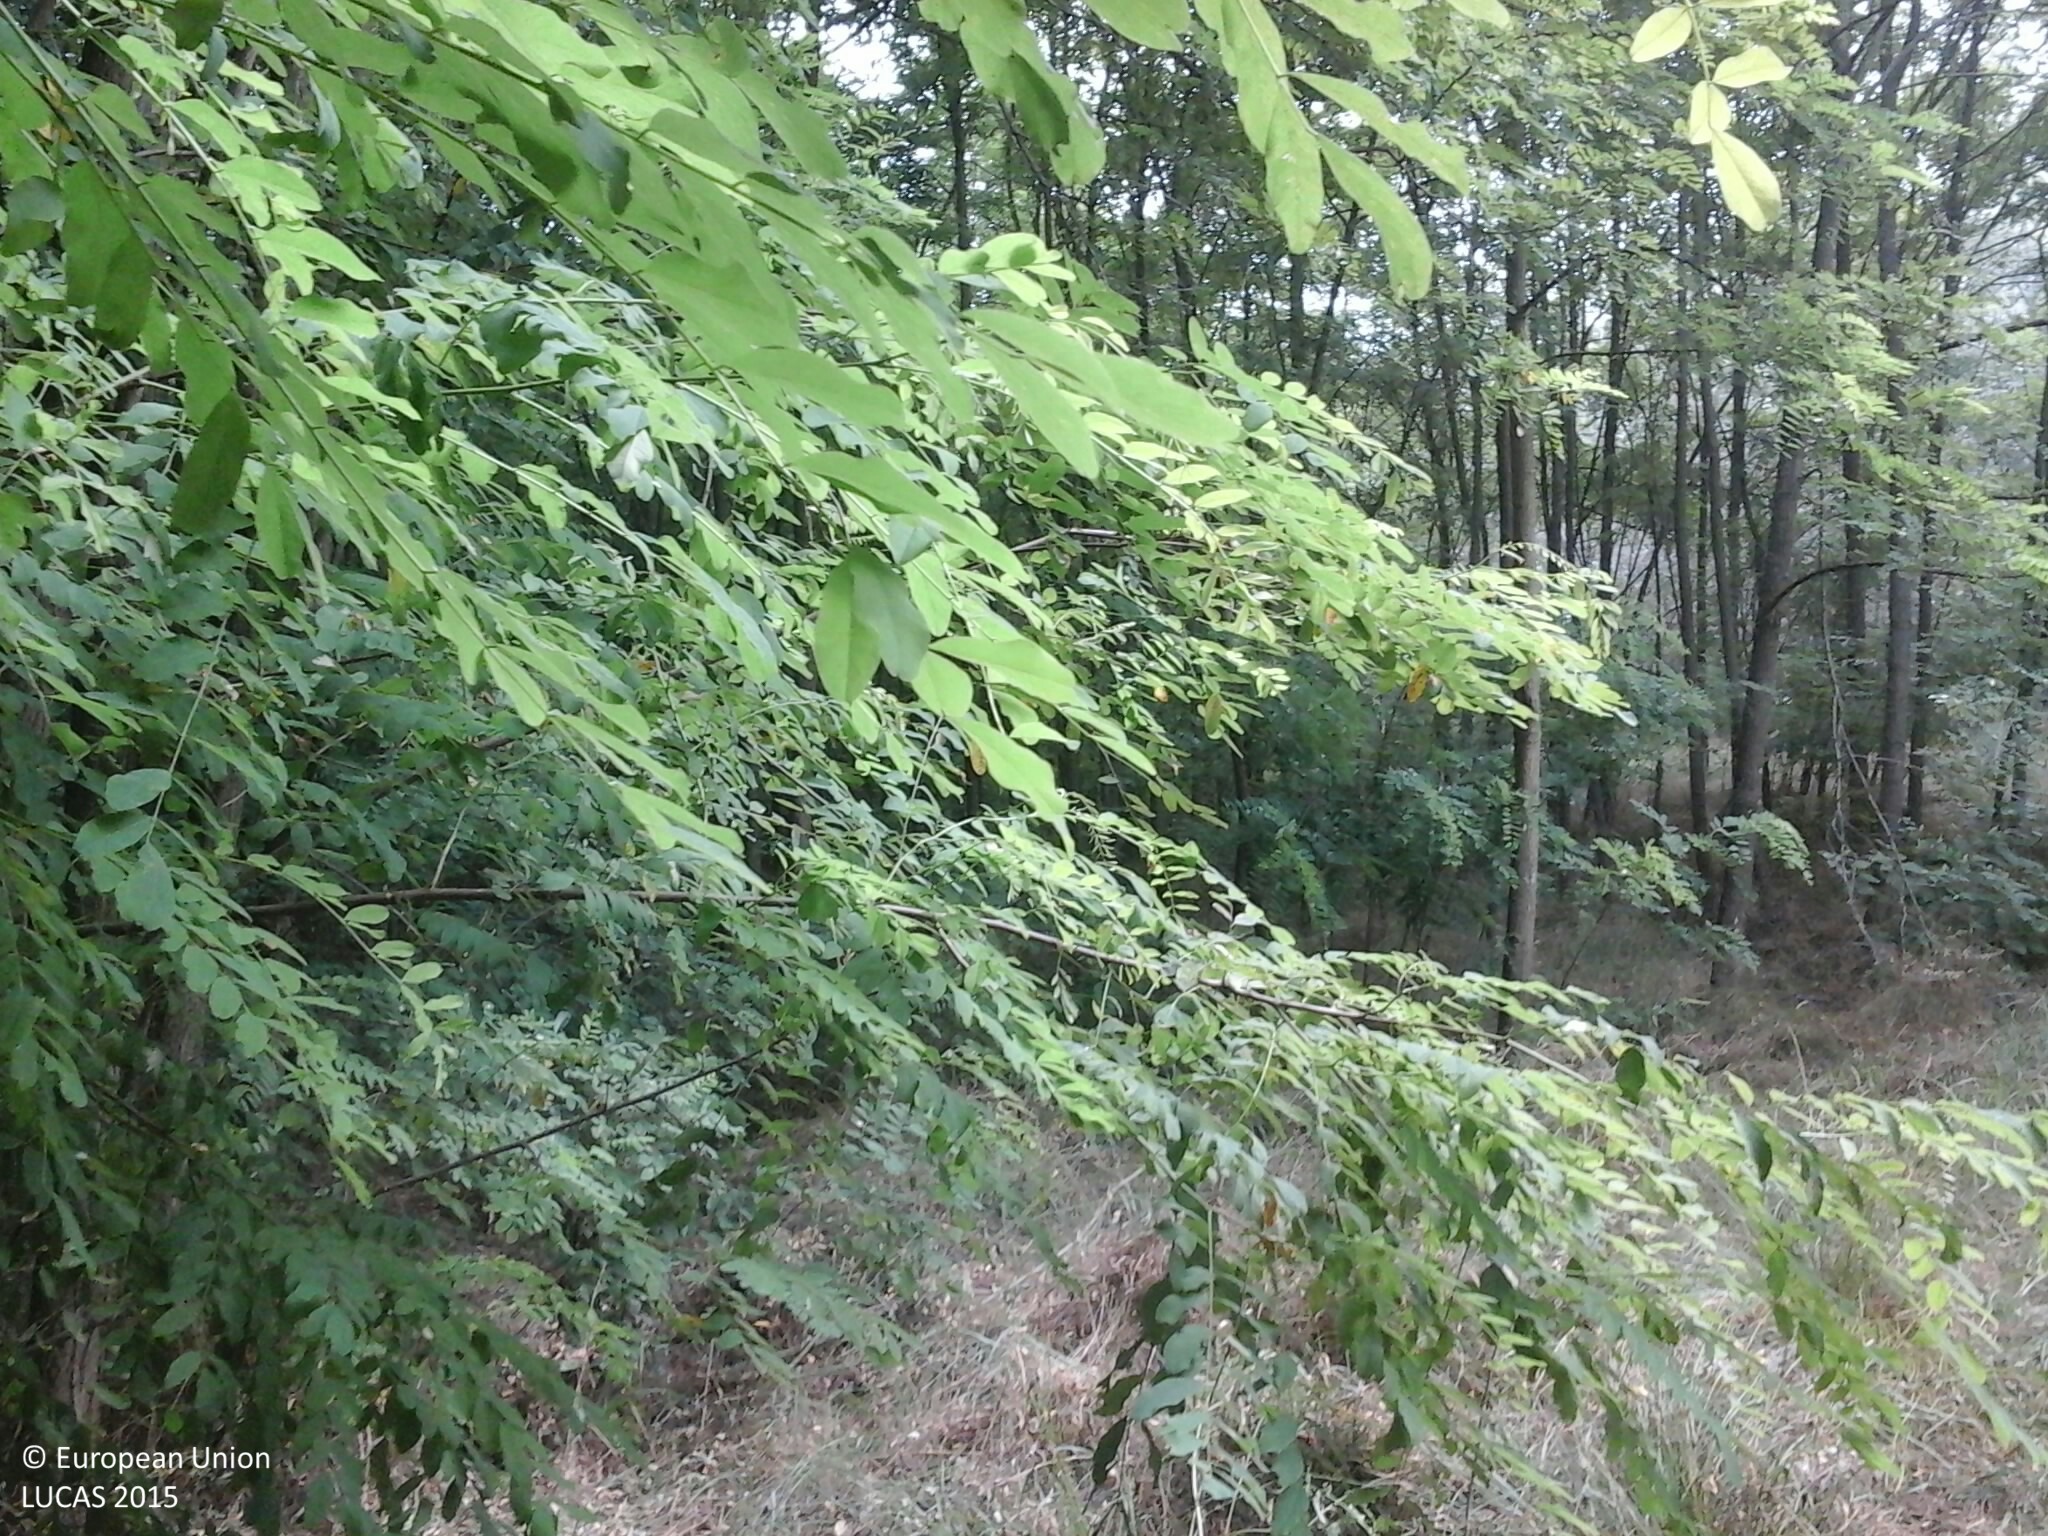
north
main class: Woodland
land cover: Broadleaved woodland
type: exotic forest
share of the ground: > 75 %
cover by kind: broadleaved forest trees 95 %, herbaceous plants 5 %
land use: Forestry
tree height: > 5 m
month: July
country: HU
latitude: 47.7871
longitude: 22.1328
